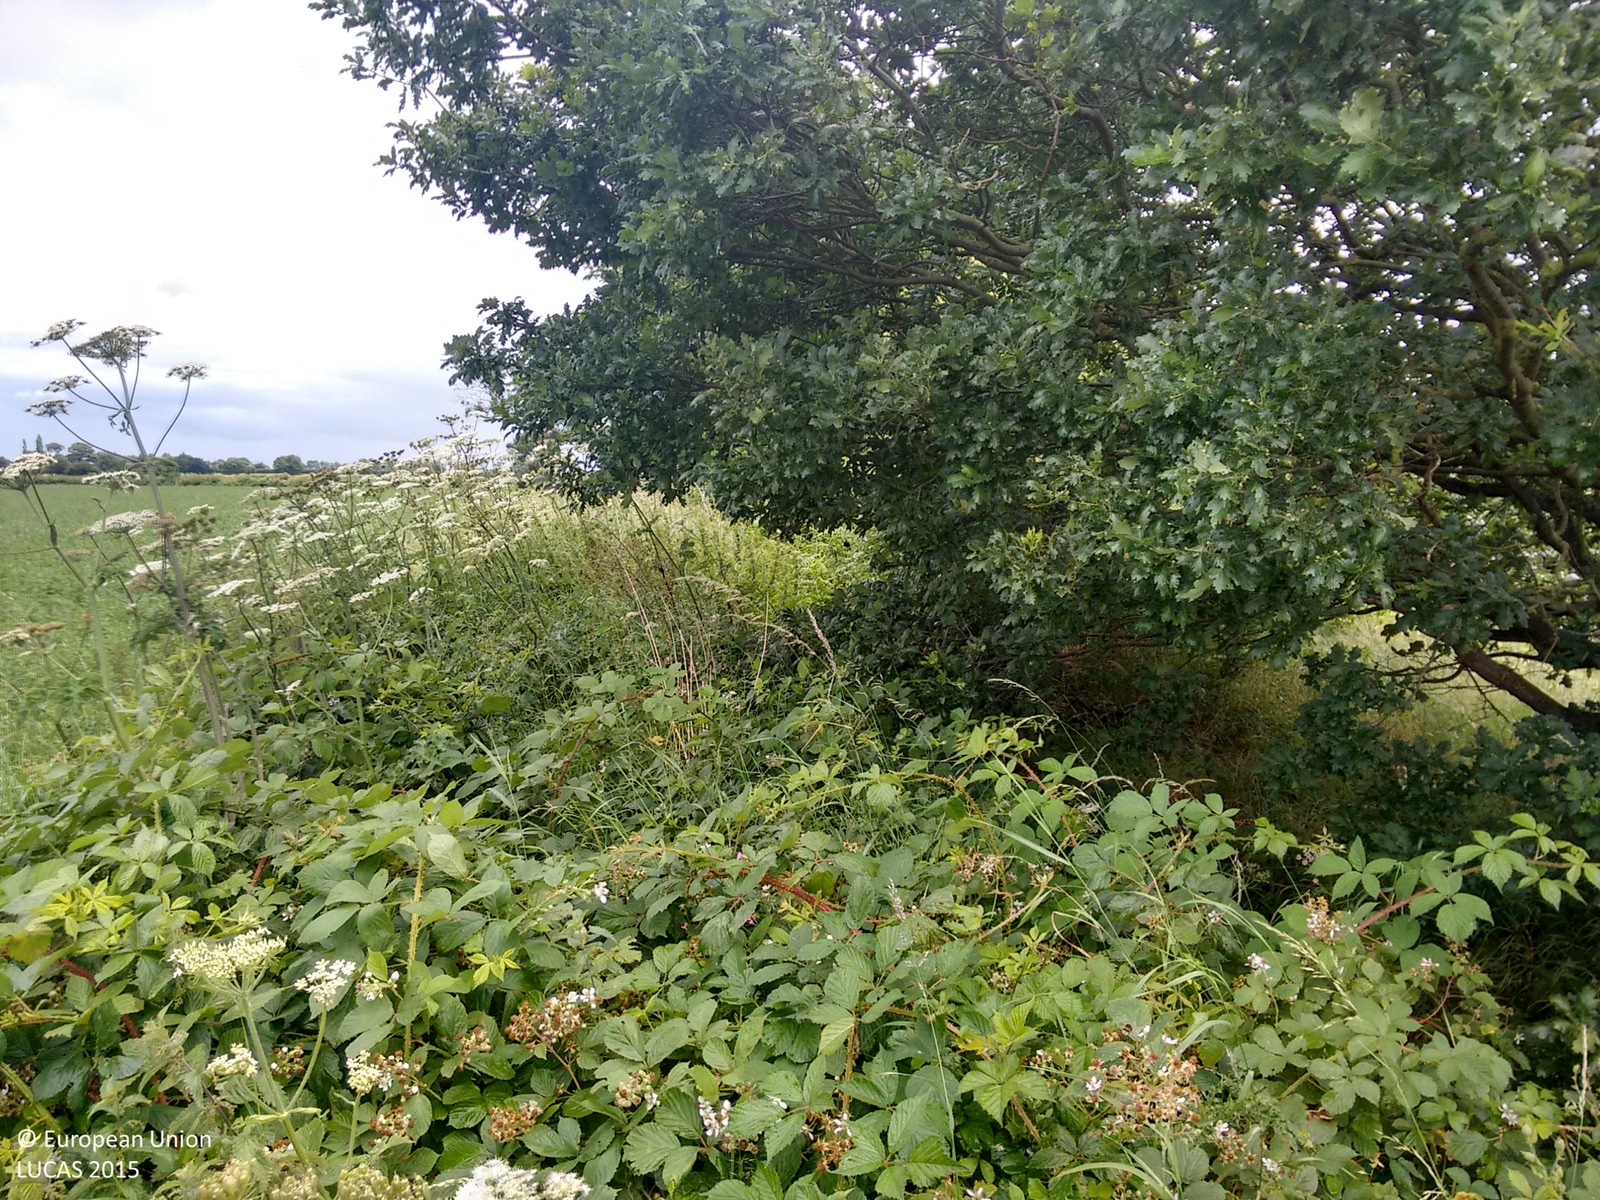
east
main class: Cropland
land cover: Other fibre and oleaginous crops
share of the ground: > 75 %
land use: Agriculture (excluding fallow land and kitchen gardens)
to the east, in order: Other fibre and oleaginous crops; Grass margins; Ditches and canals; Grass margins; Other root crops
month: July
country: GB
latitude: 53.4270
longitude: -0.9843
